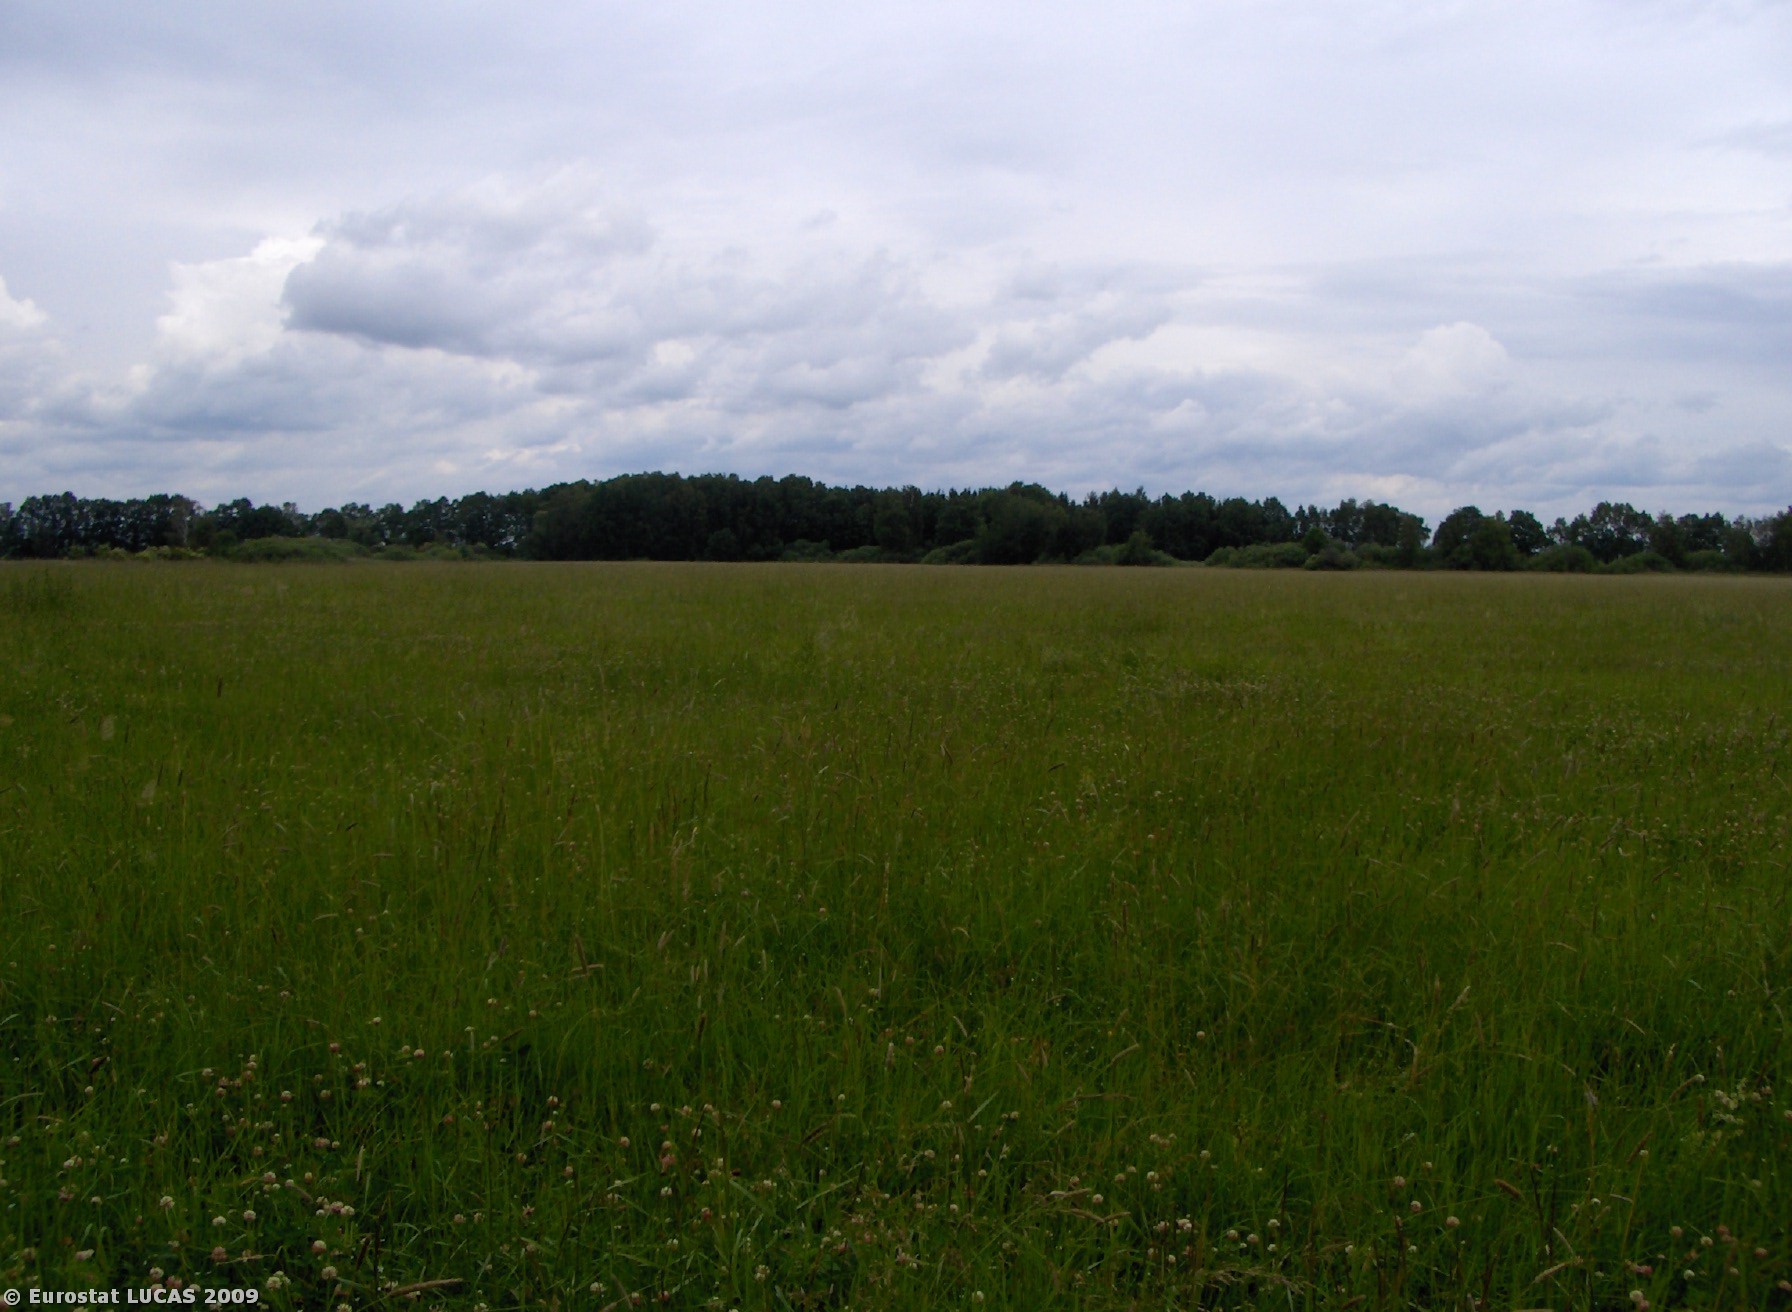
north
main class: Grassland
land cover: Grassland without tree/shrub cover
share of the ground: > 75 %
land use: Agriculture (excluding fallow land and kitchen gardens)
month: June
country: CZ
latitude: 49.0412
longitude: 14.2827
